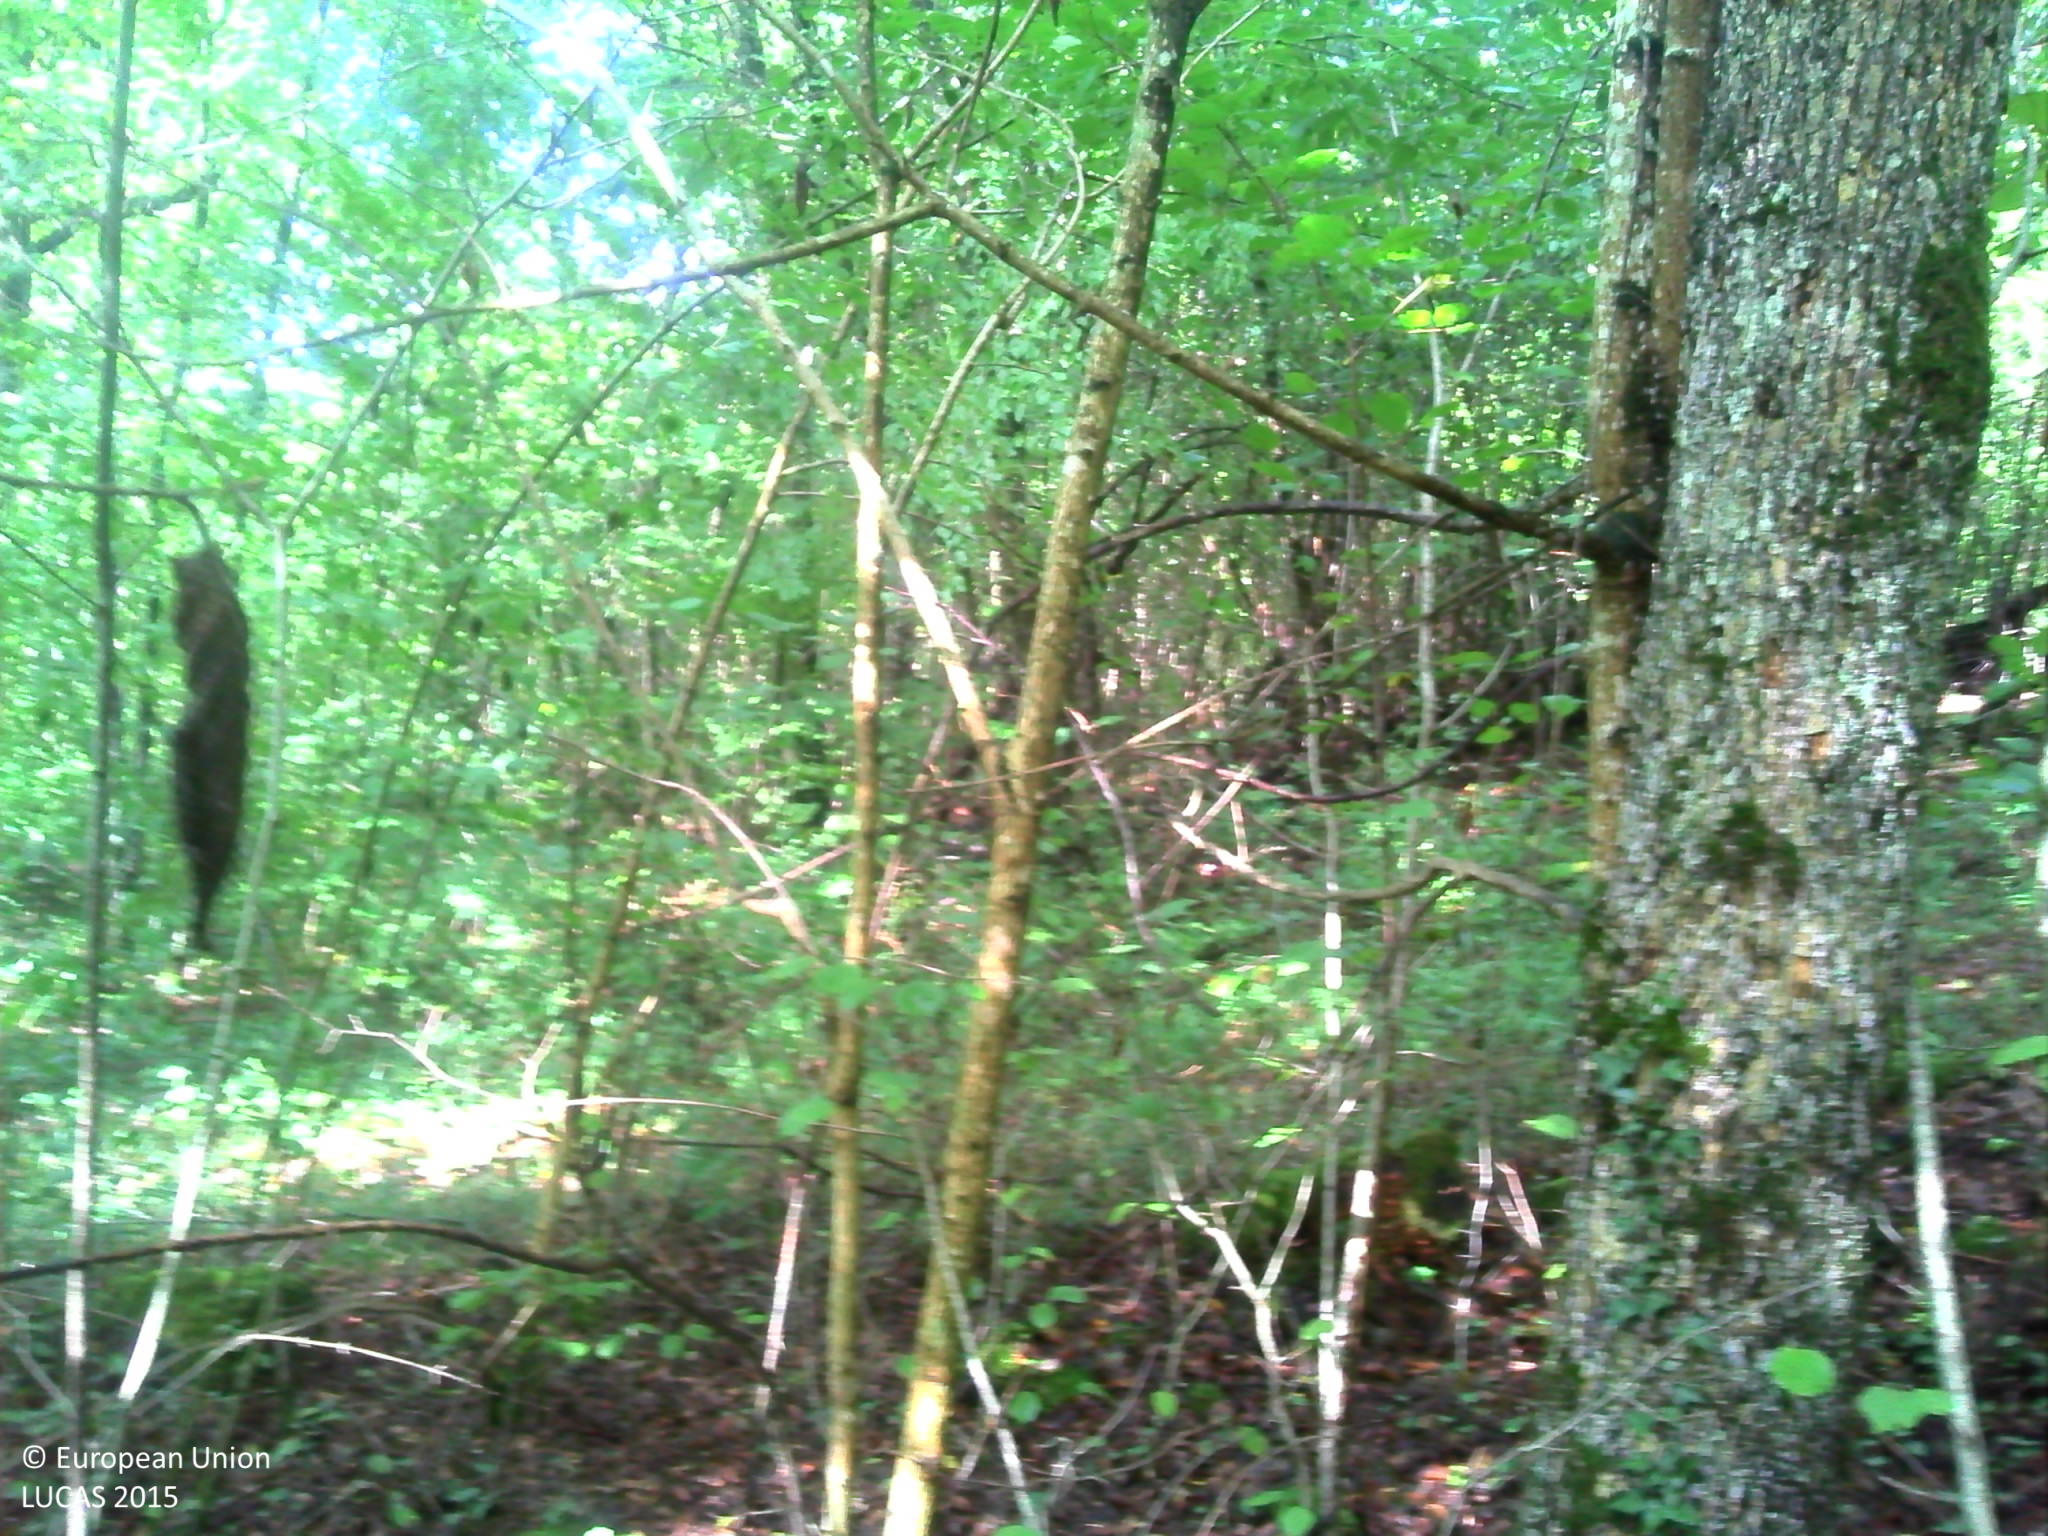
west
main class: Woodland
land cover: Broadleaved woodland
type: mesophytic deciduous forest
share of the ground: > 75 %
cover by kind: broadleaved forest trees 90 %, herbaceous plants 5 %, consolidated bare surface 5 %
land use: Forestry
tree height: > 5 m
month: September
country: FR
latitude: 48.8349
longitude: 5.9807
